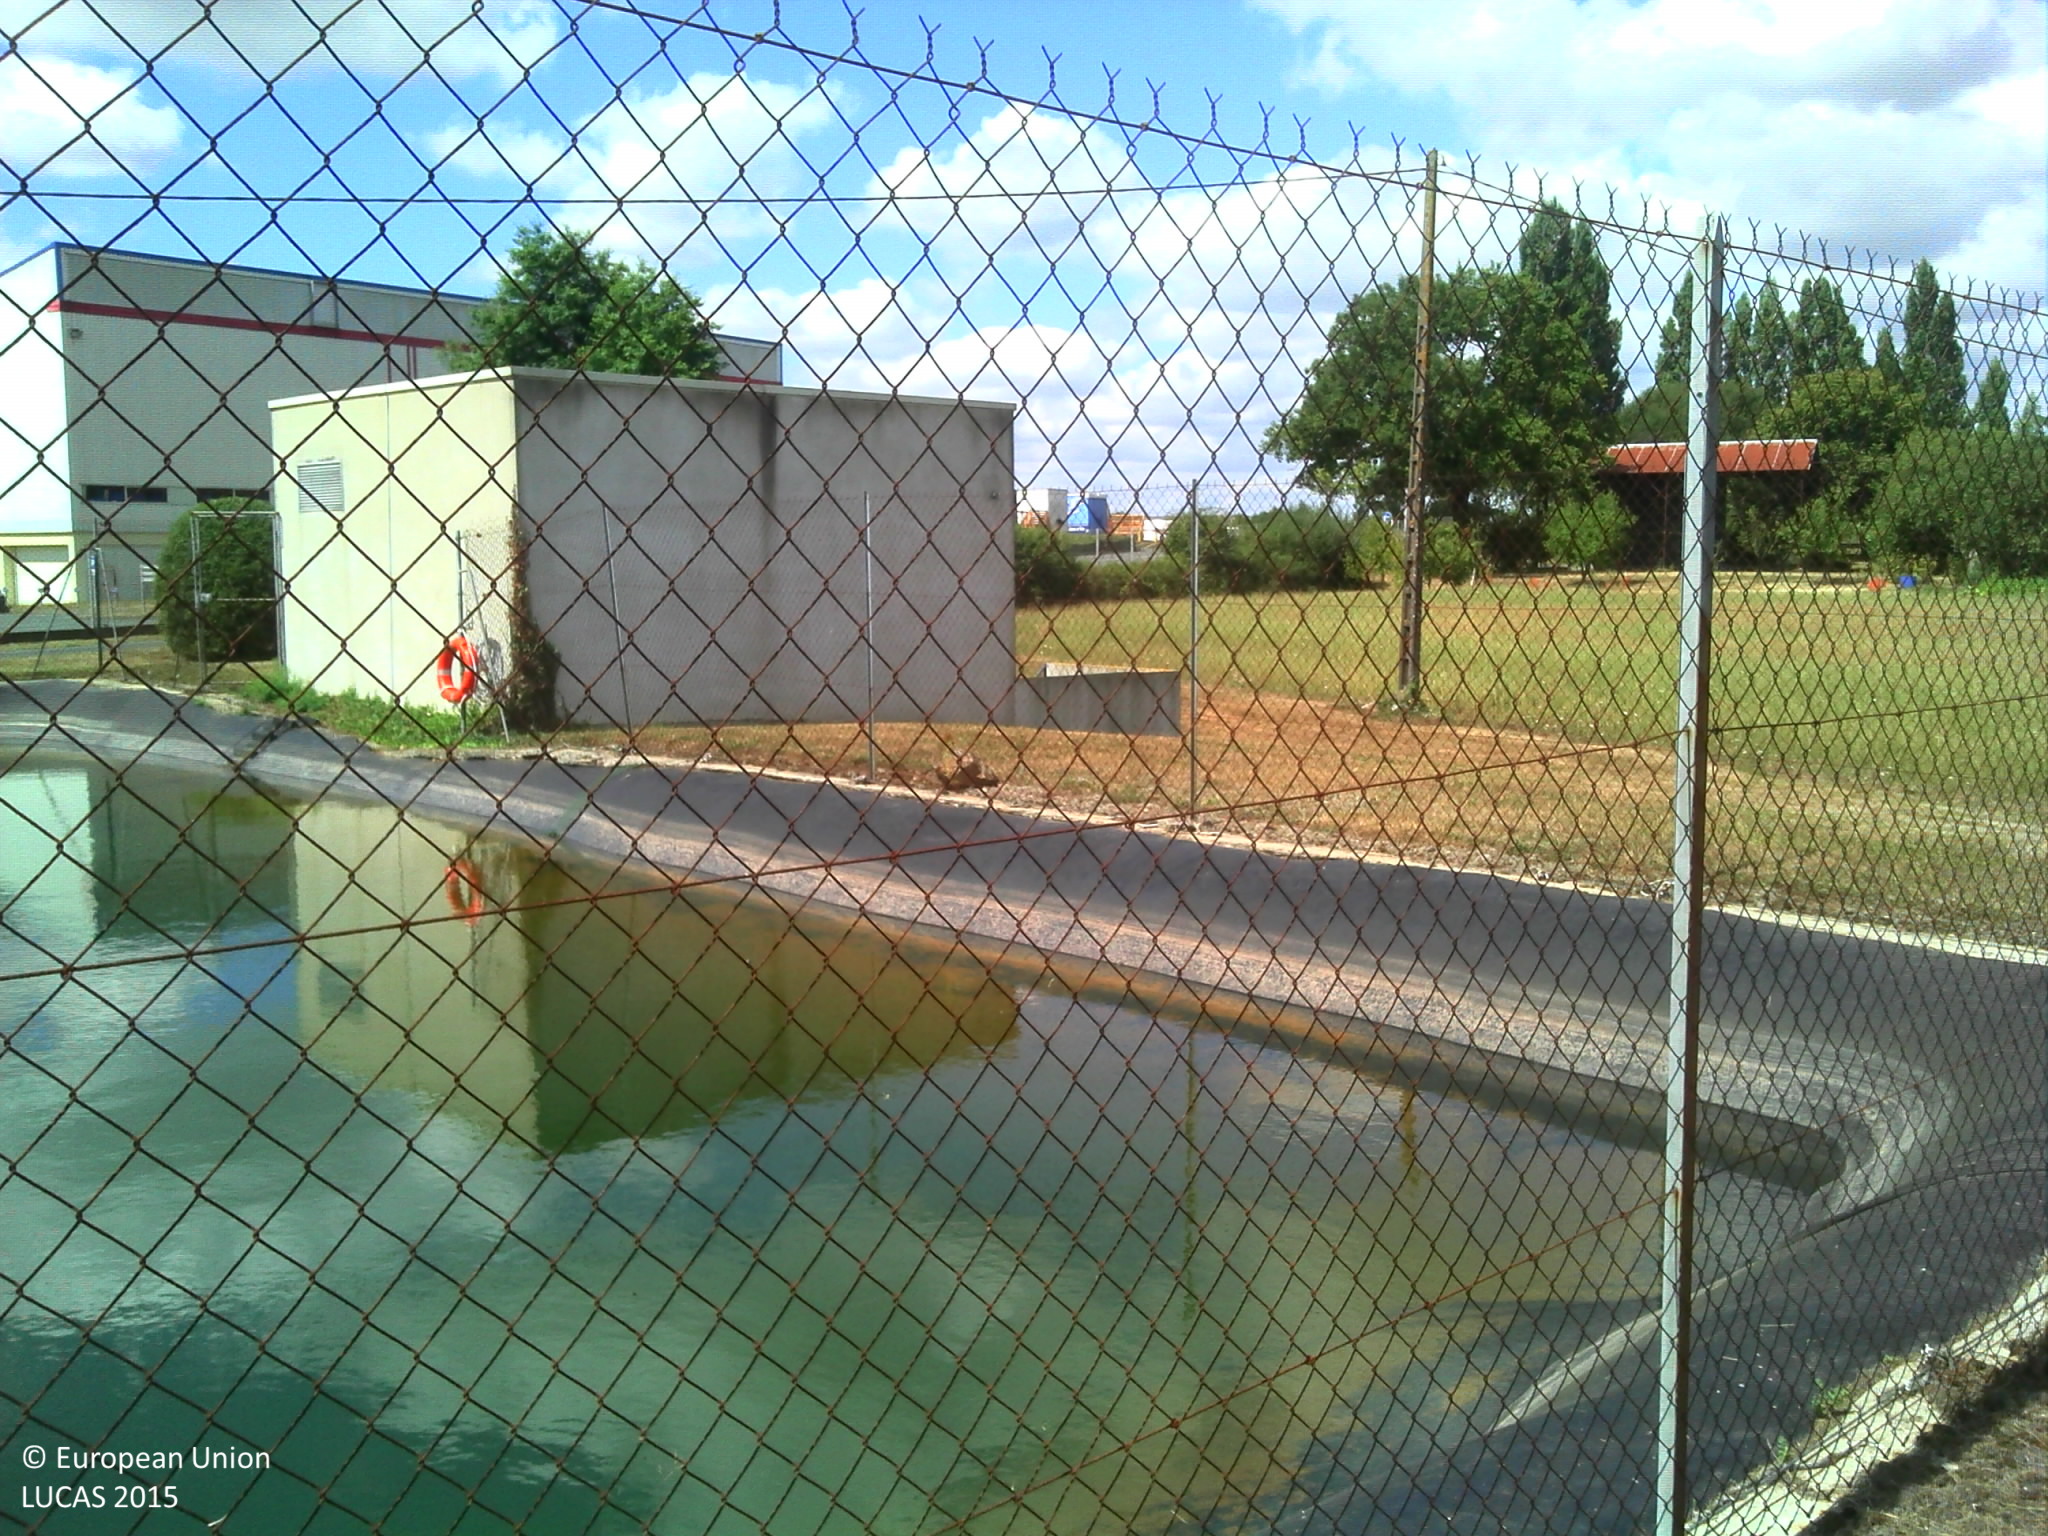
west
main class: Grassland
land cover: Grassland without tree/shrub cover
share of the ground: > 75 %
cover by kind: herbaceous plants 100 %
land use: Water supply and treatment
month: July
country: FR
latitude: 46.9879
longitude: -0.9333
